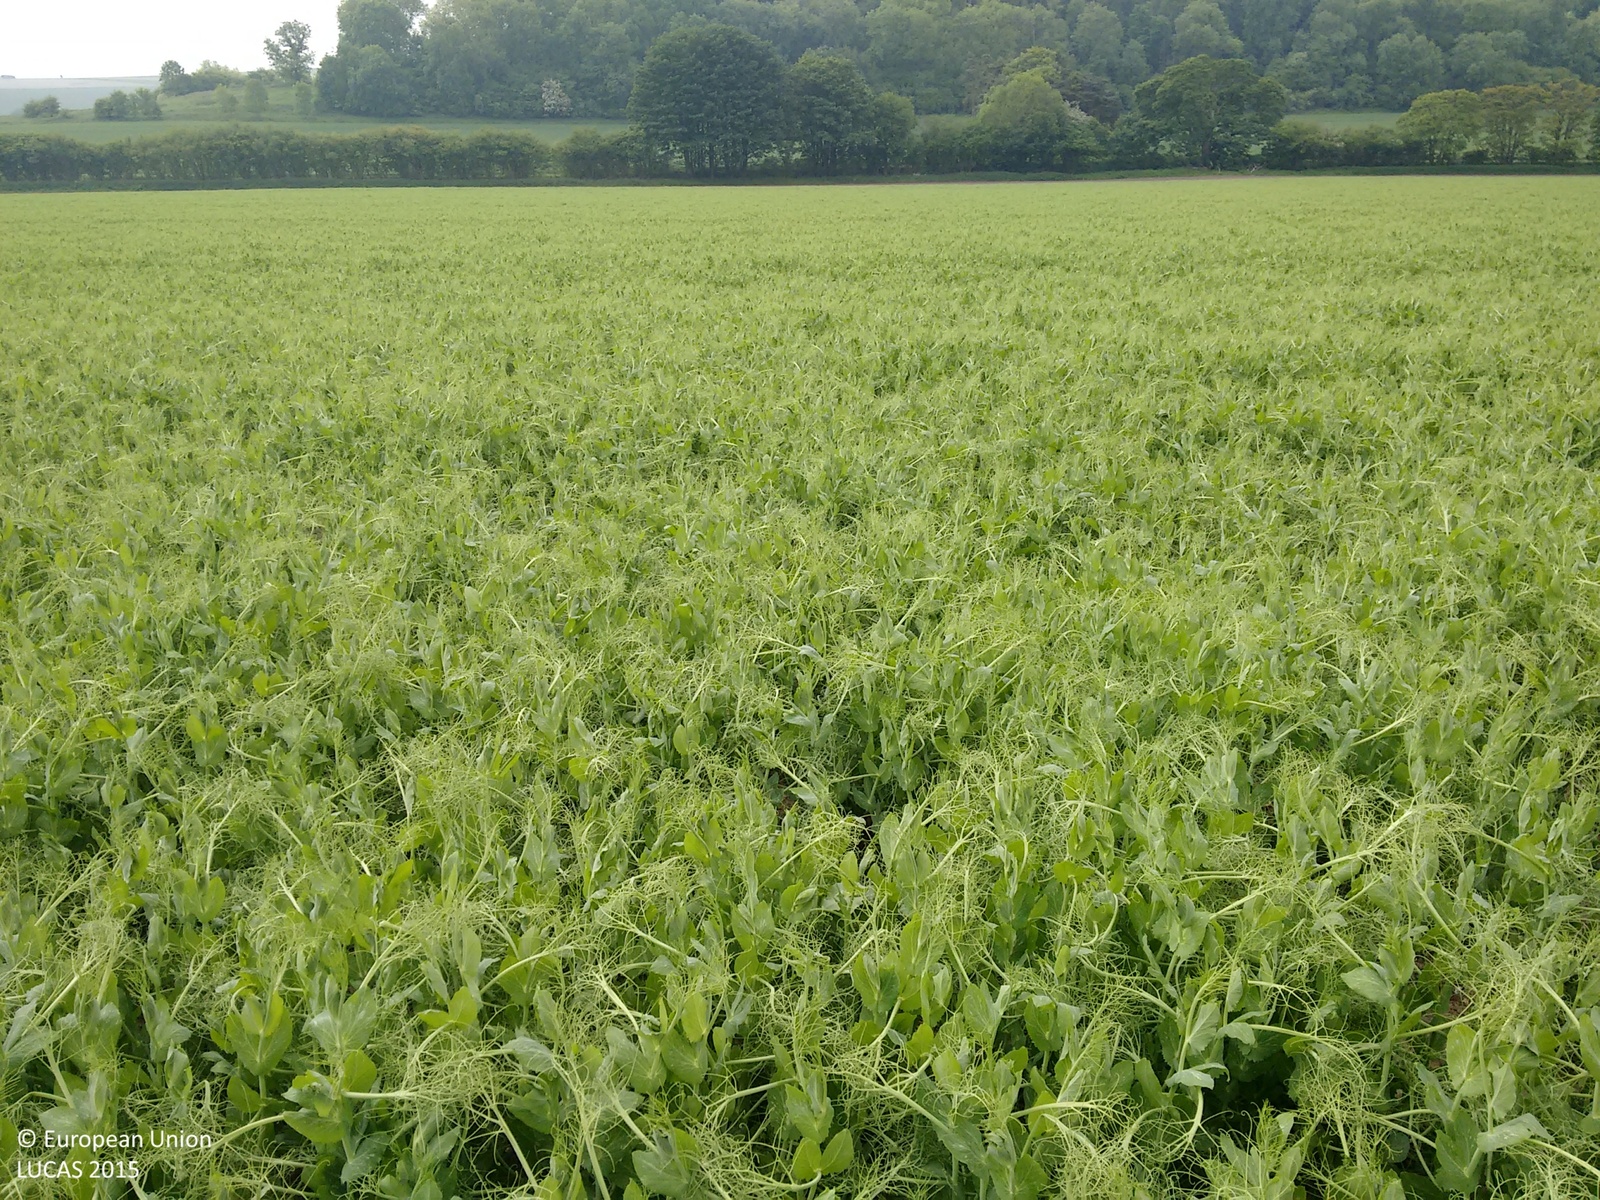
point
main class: Cropland
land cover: Dry pulses
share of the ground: > 75 %
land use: Agriculture (excluding fallow land and kitchen gardens)
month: June
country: GB
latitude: 51.1600
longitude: -2.2305
